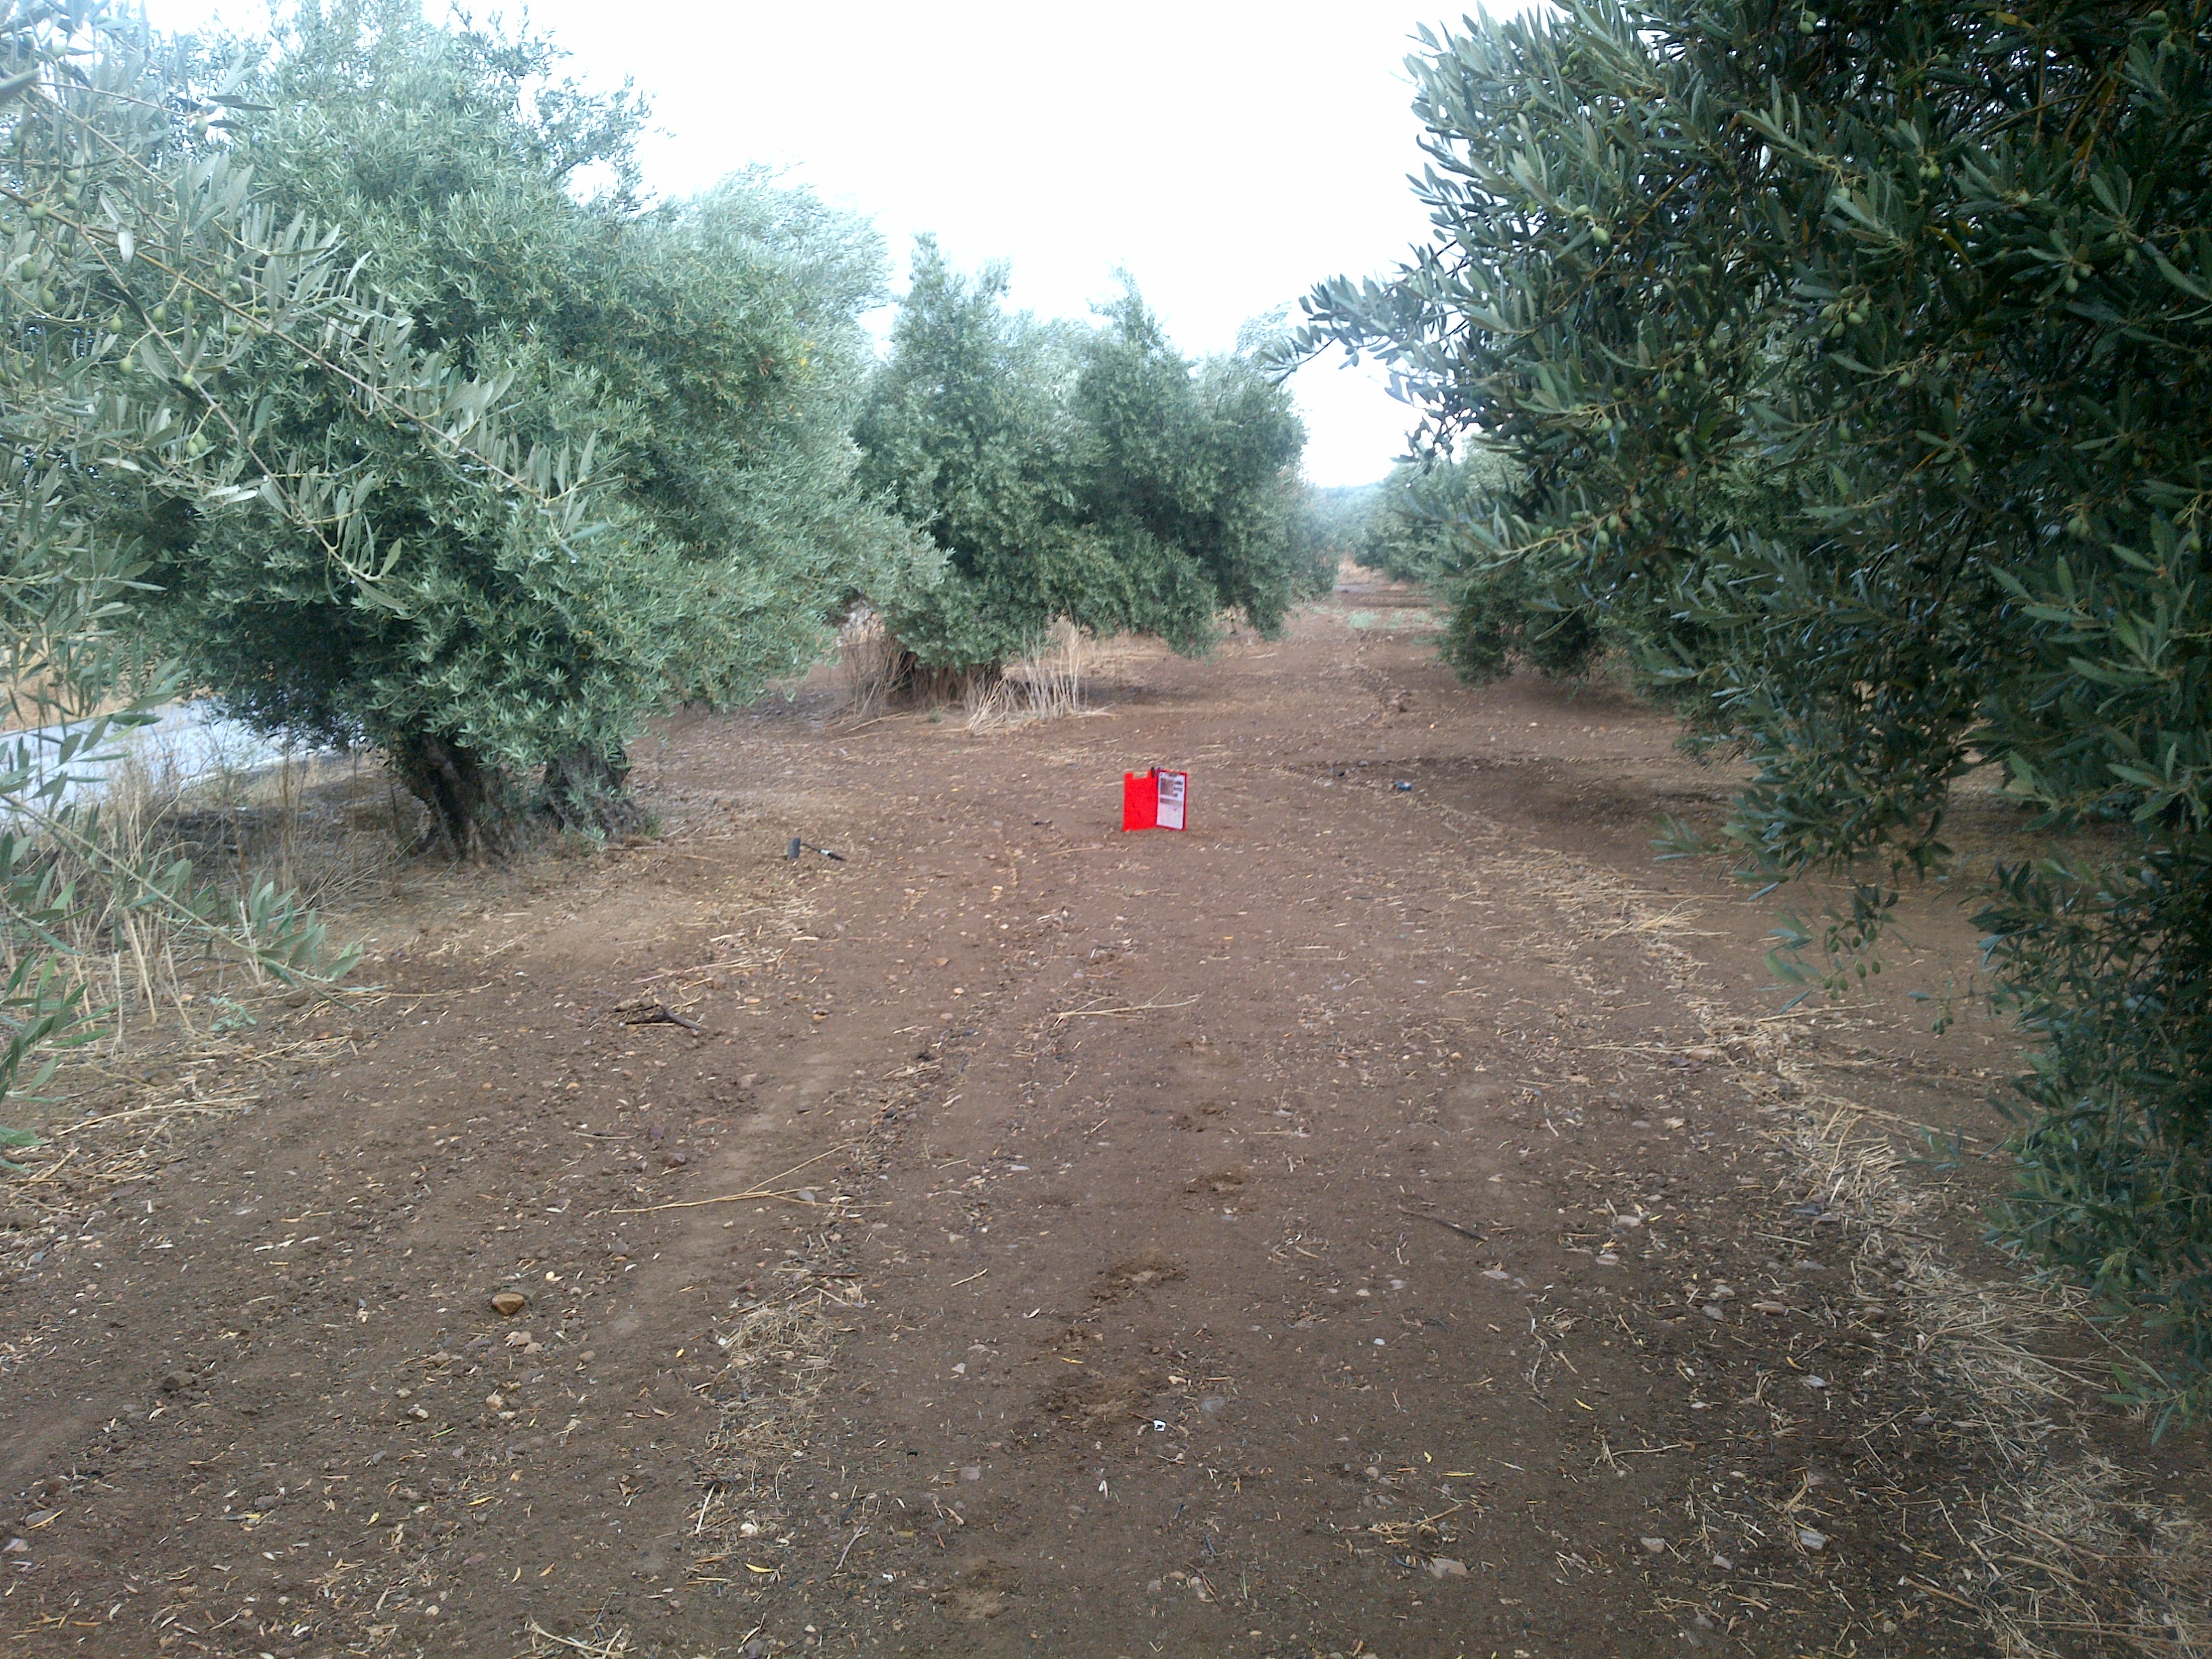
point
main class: Cropland
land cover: Olive groves
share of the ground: 50 - 75 %
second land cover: Other bare soil
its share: > 75 %
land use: Agriculture (excluding fallow land and kitchen gardens)
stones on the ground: < 10 %
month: June
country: ES
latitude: 37.9629
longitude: -4.3172
